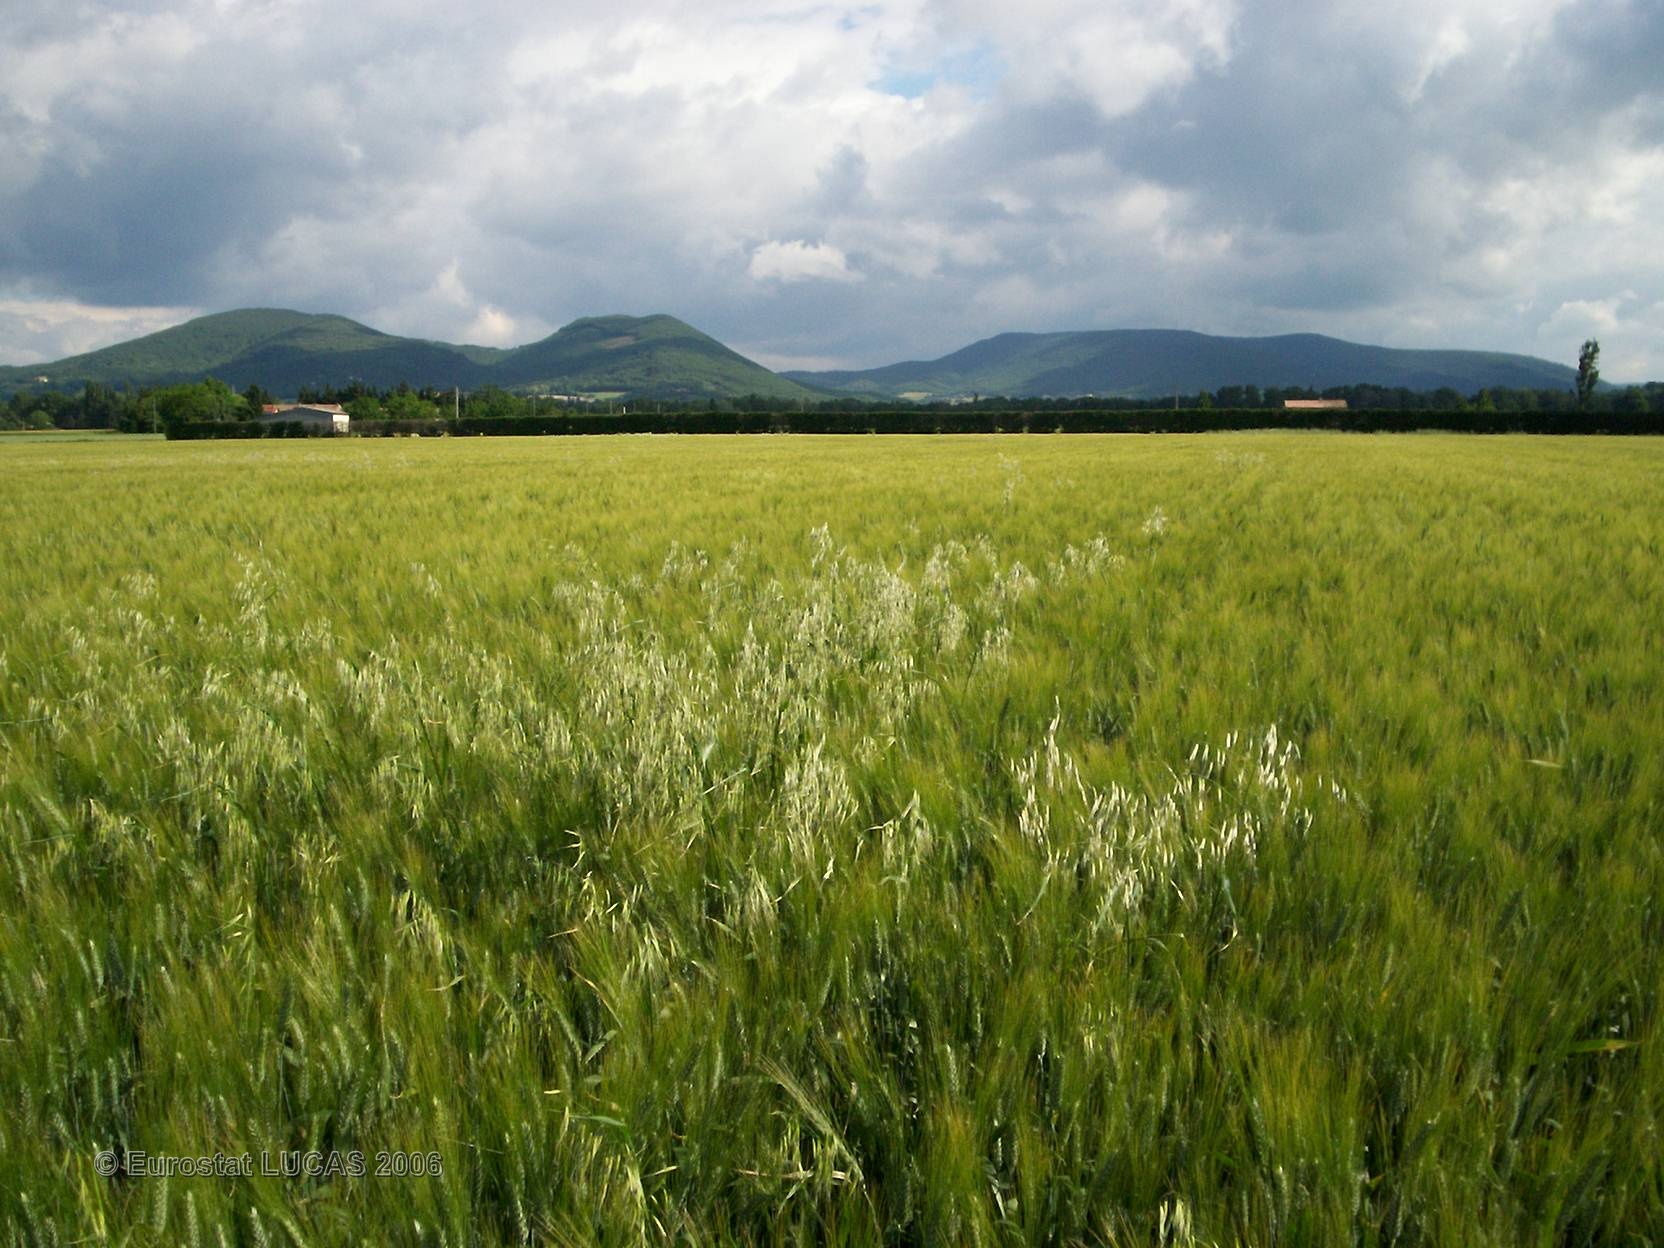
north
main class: Cropland
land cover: Durum wheat
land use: Agriculture (excluding fallow land and kitchen gardens)
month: May
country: FR
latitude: 44.5831
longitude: 4.8302
